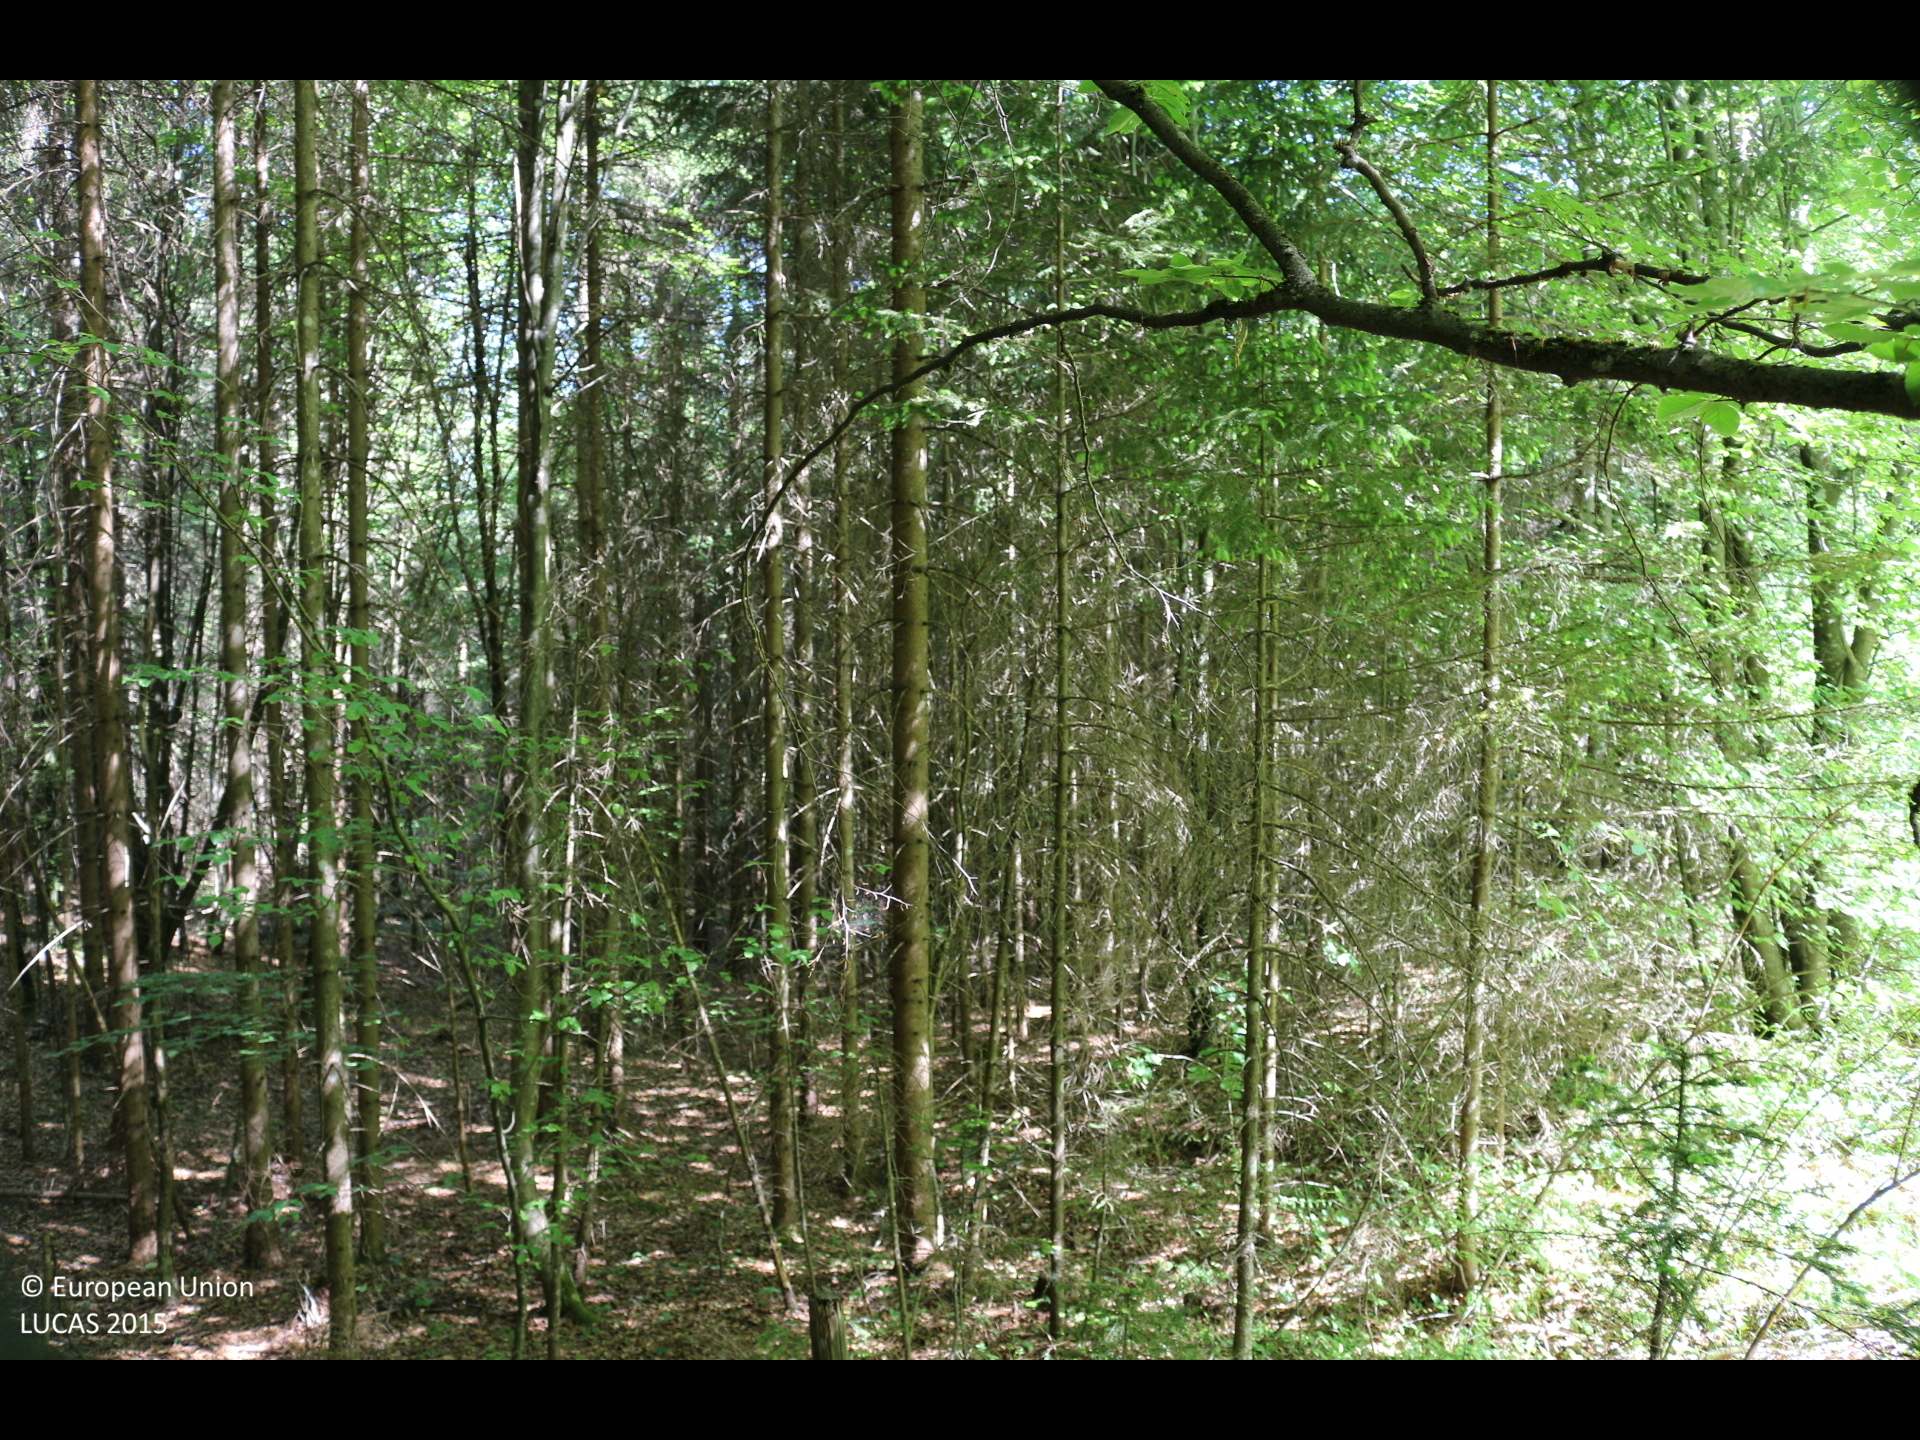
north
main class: Woodland
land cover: Spruce dominated mixed woodland
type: mountainous beech forest
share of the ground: > 75 %
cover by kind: coniferous forest trees 60 %, broadleaved forest trees 40 %
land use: Forestry
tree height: > 5 m
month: May
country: AT
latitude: 46.5168
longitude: 14.3116
